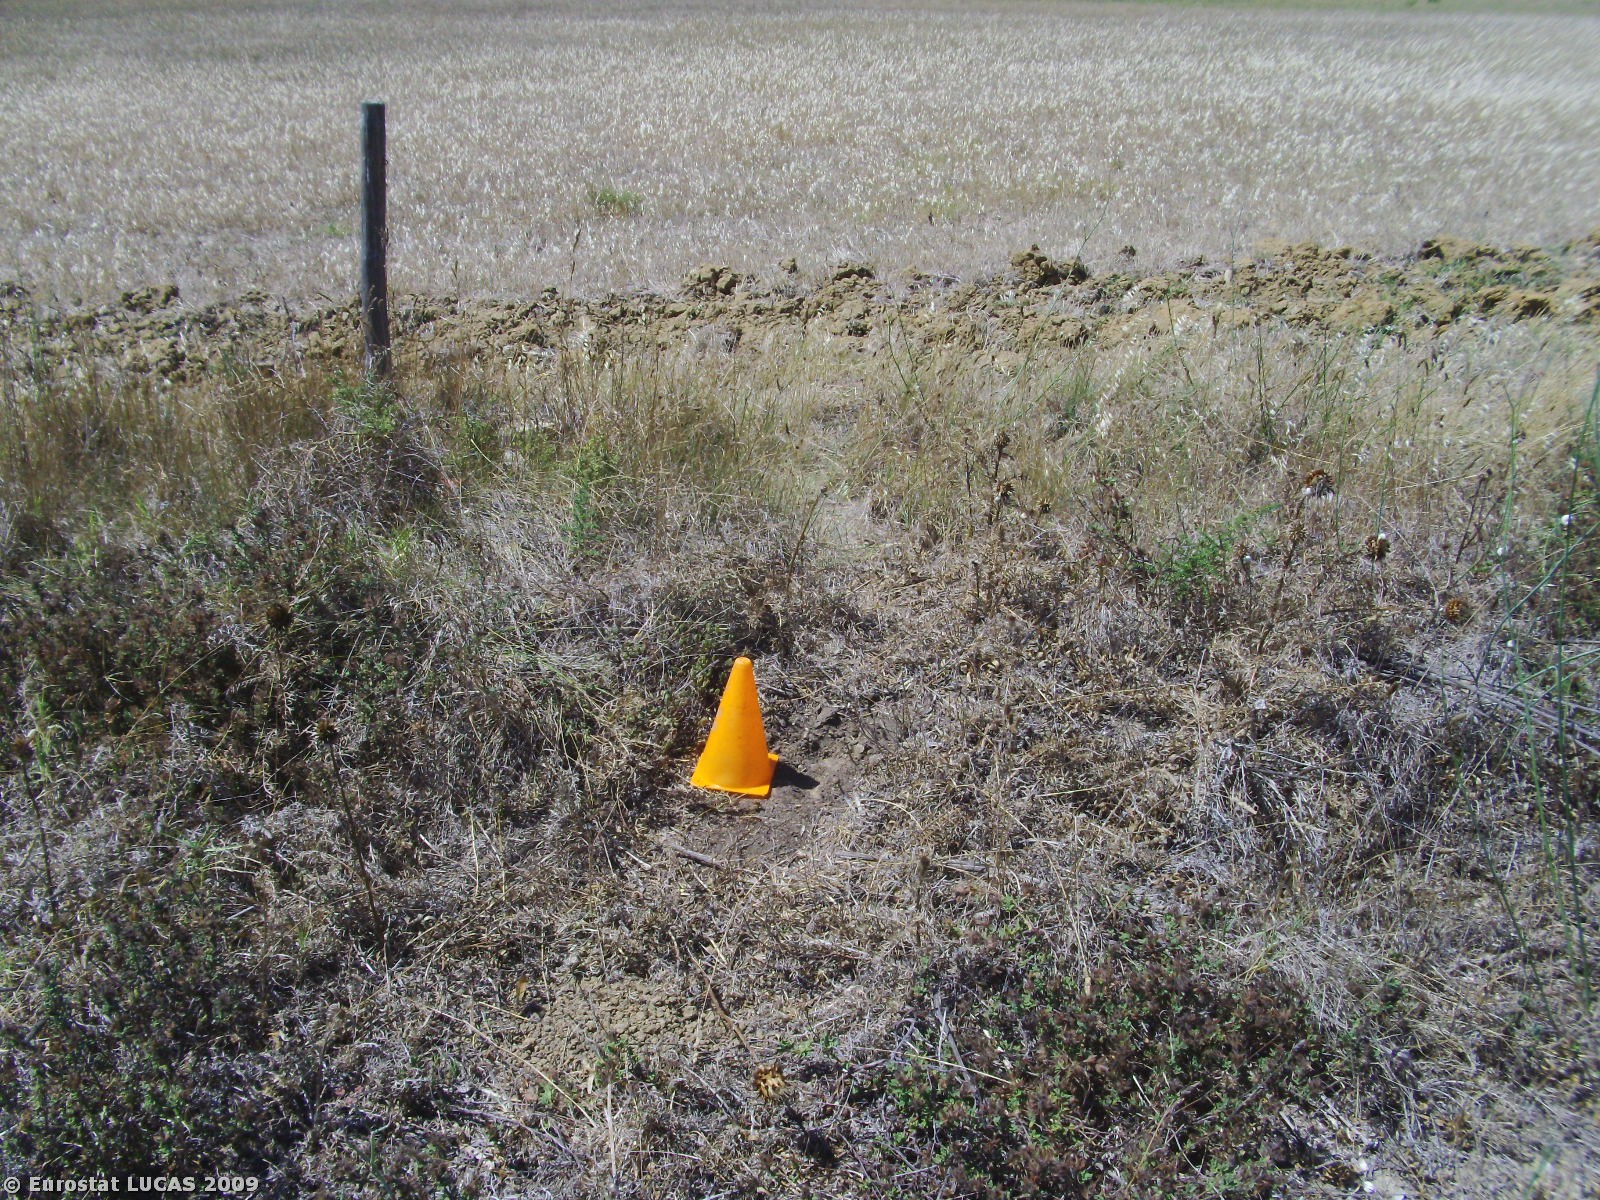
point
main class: Grassland
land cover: Spontaneously vegetated surfaces
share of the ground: > 75 %
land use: Fallow land
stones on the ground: 25 - 50 %
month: July
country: PT
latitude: 39.1336
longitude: -8.9938
